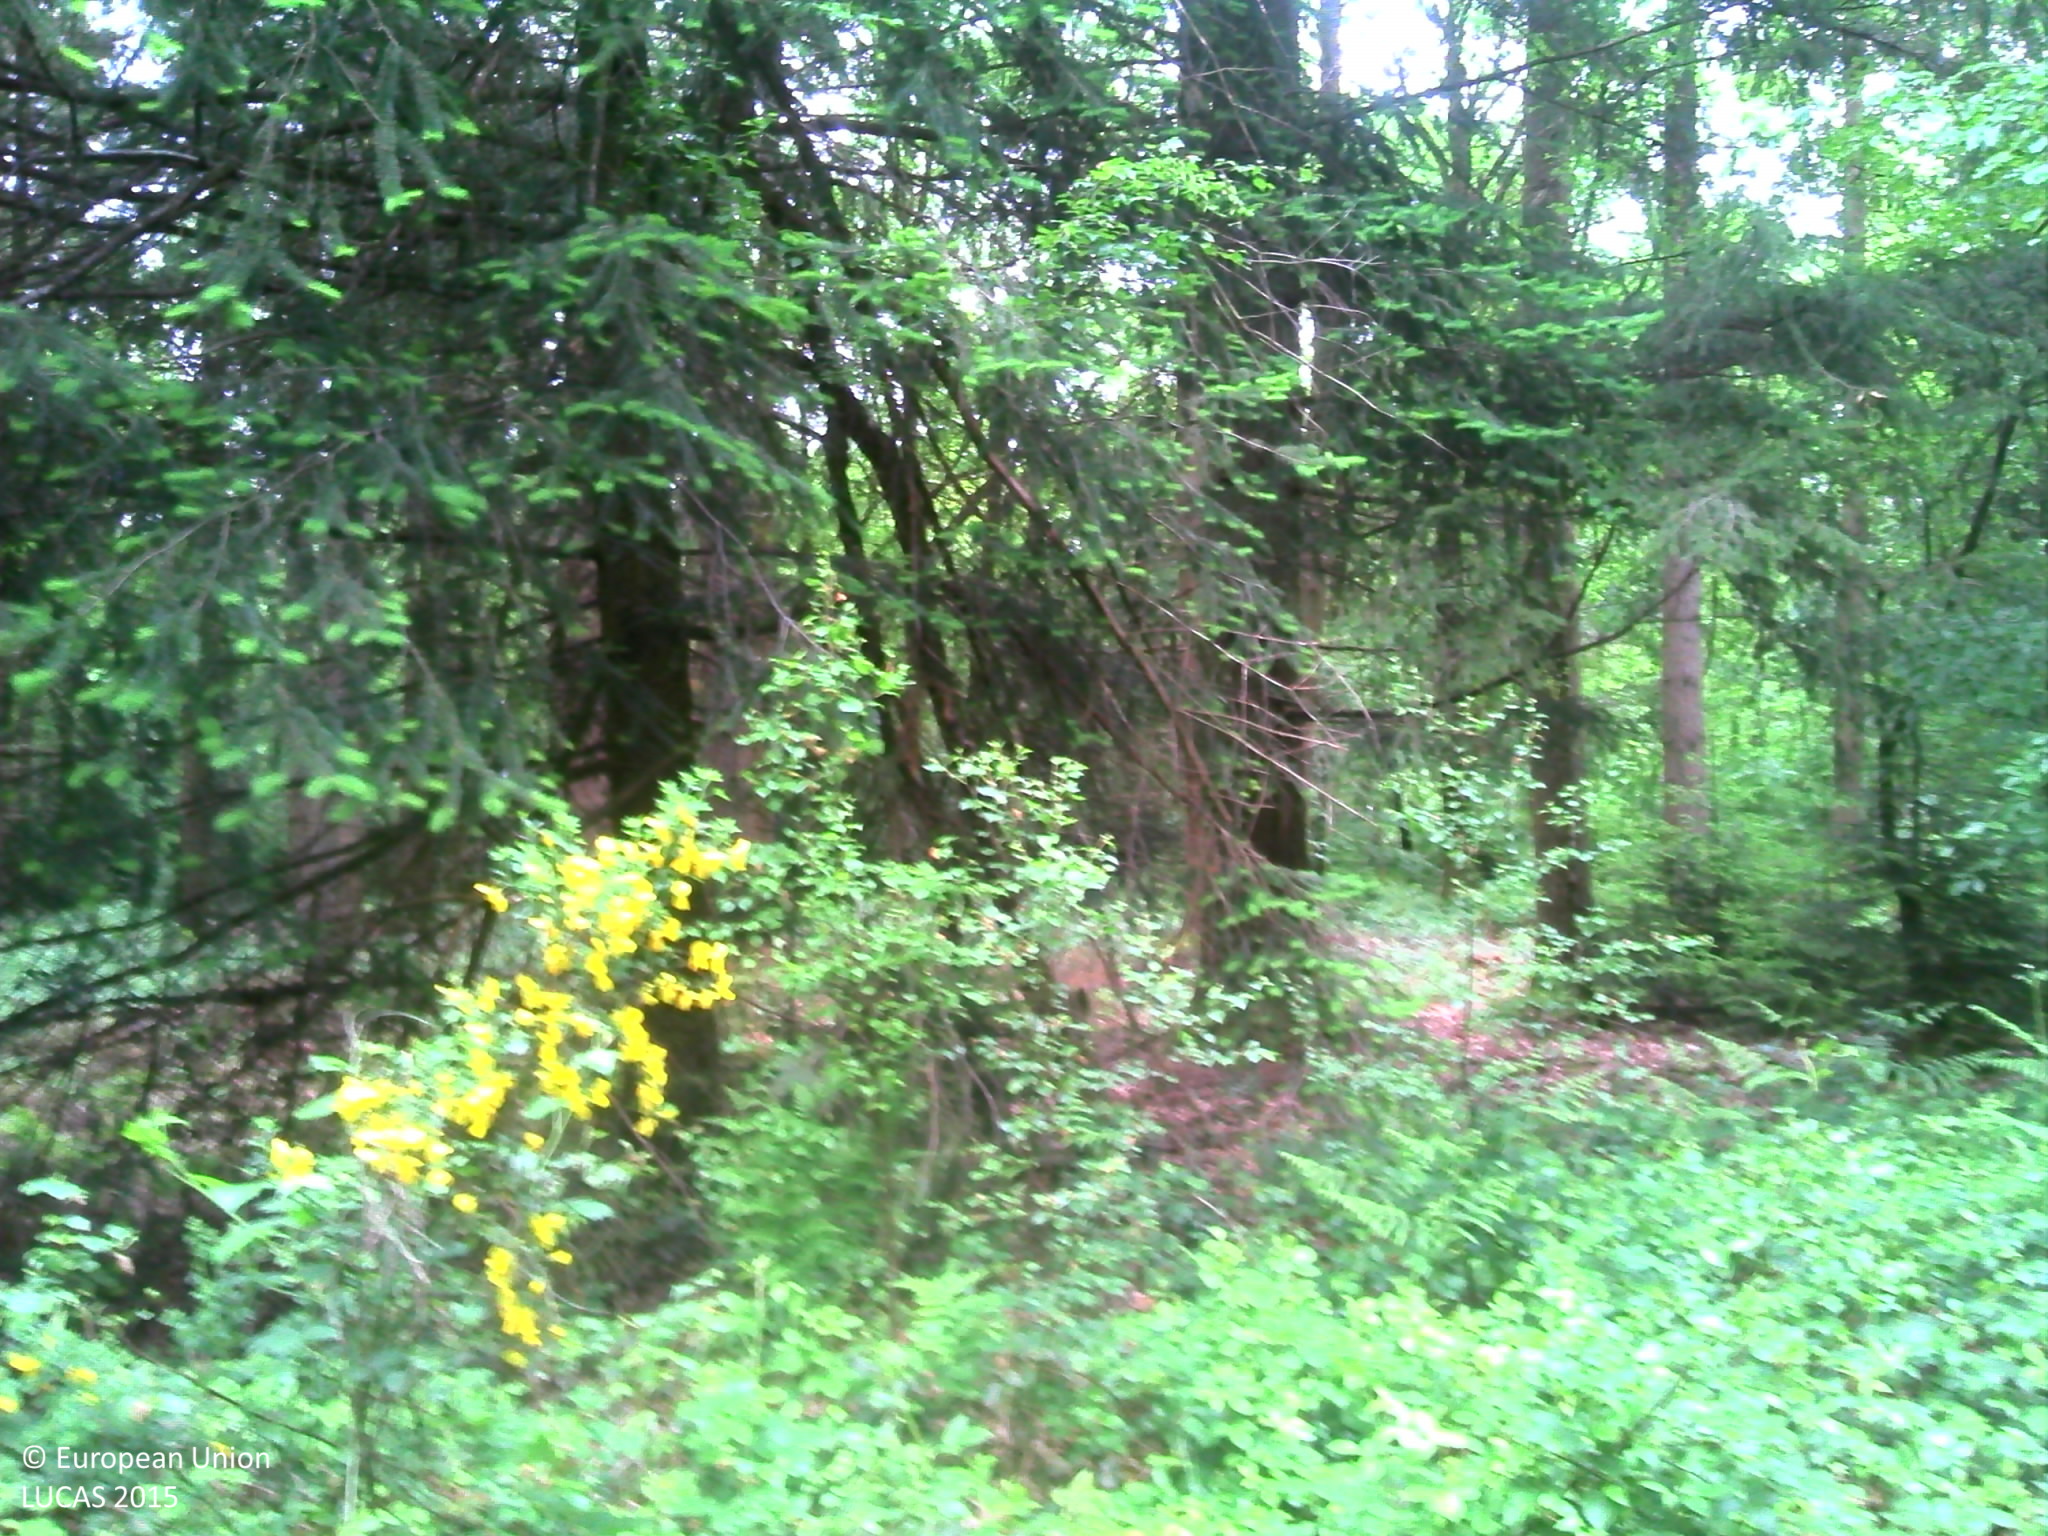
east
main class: Woodland
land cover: Other mixed woodland
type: acidophilous oak and oak-birch forest
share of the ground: > 75 %
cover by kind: coniferous forest trees 65 %, broadleaved forest trees 30 %, herbaceous plants 5 %
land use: Forestry
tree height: > 5 m
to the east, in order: Other mixed woodland; Broadleaved woodland; Other coniferous woodland; Tracks; Nurseries
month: June
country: BE
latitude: 49.9445
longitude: 4.9108
